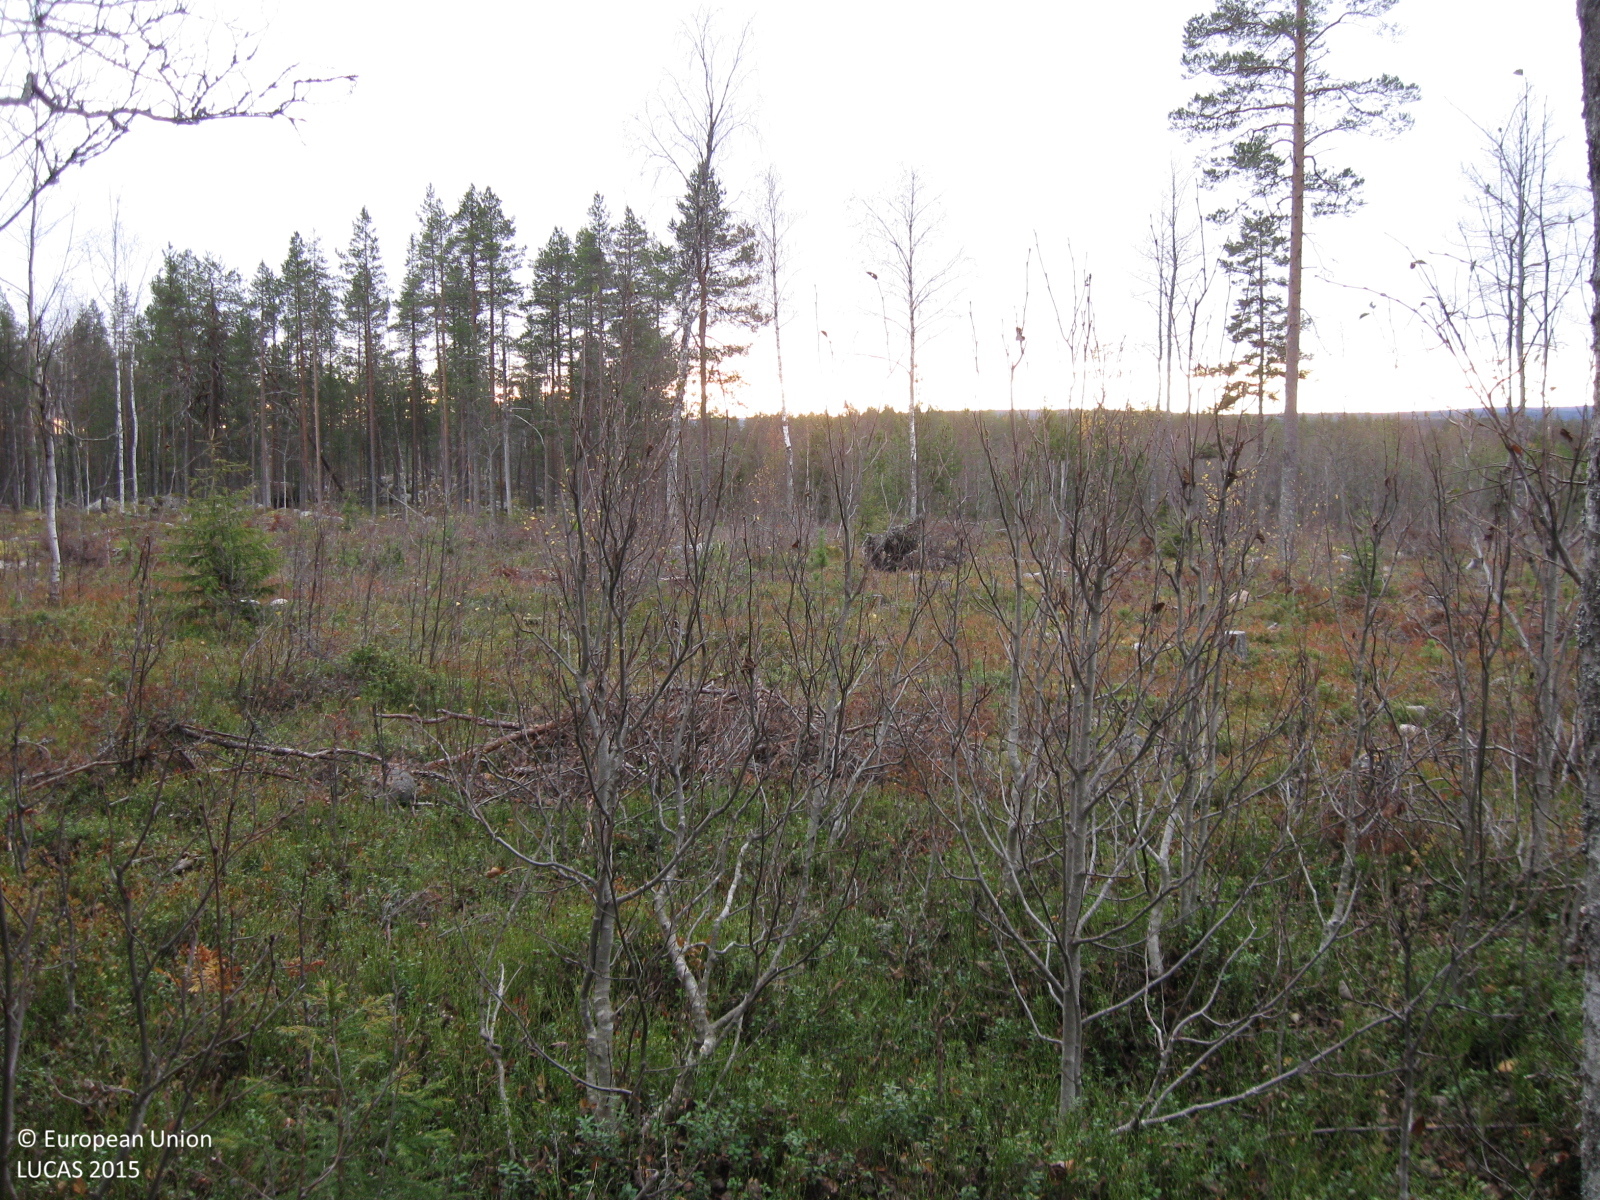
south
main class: Woodland
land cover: Broadleaved woodland
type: non-riverine alder, birch or aspen forest
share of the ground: > 75 %
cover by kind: broadleaved forest trees 75 %, herbaceous plants 10 %, coniferous forest trees 5 %, shrubs 5 %, lichens and mosses 5 %
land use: Forestry
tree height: > 5 m
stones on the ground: < 10 %
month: October
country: SE
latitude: 66.0601
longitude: 22.0980
